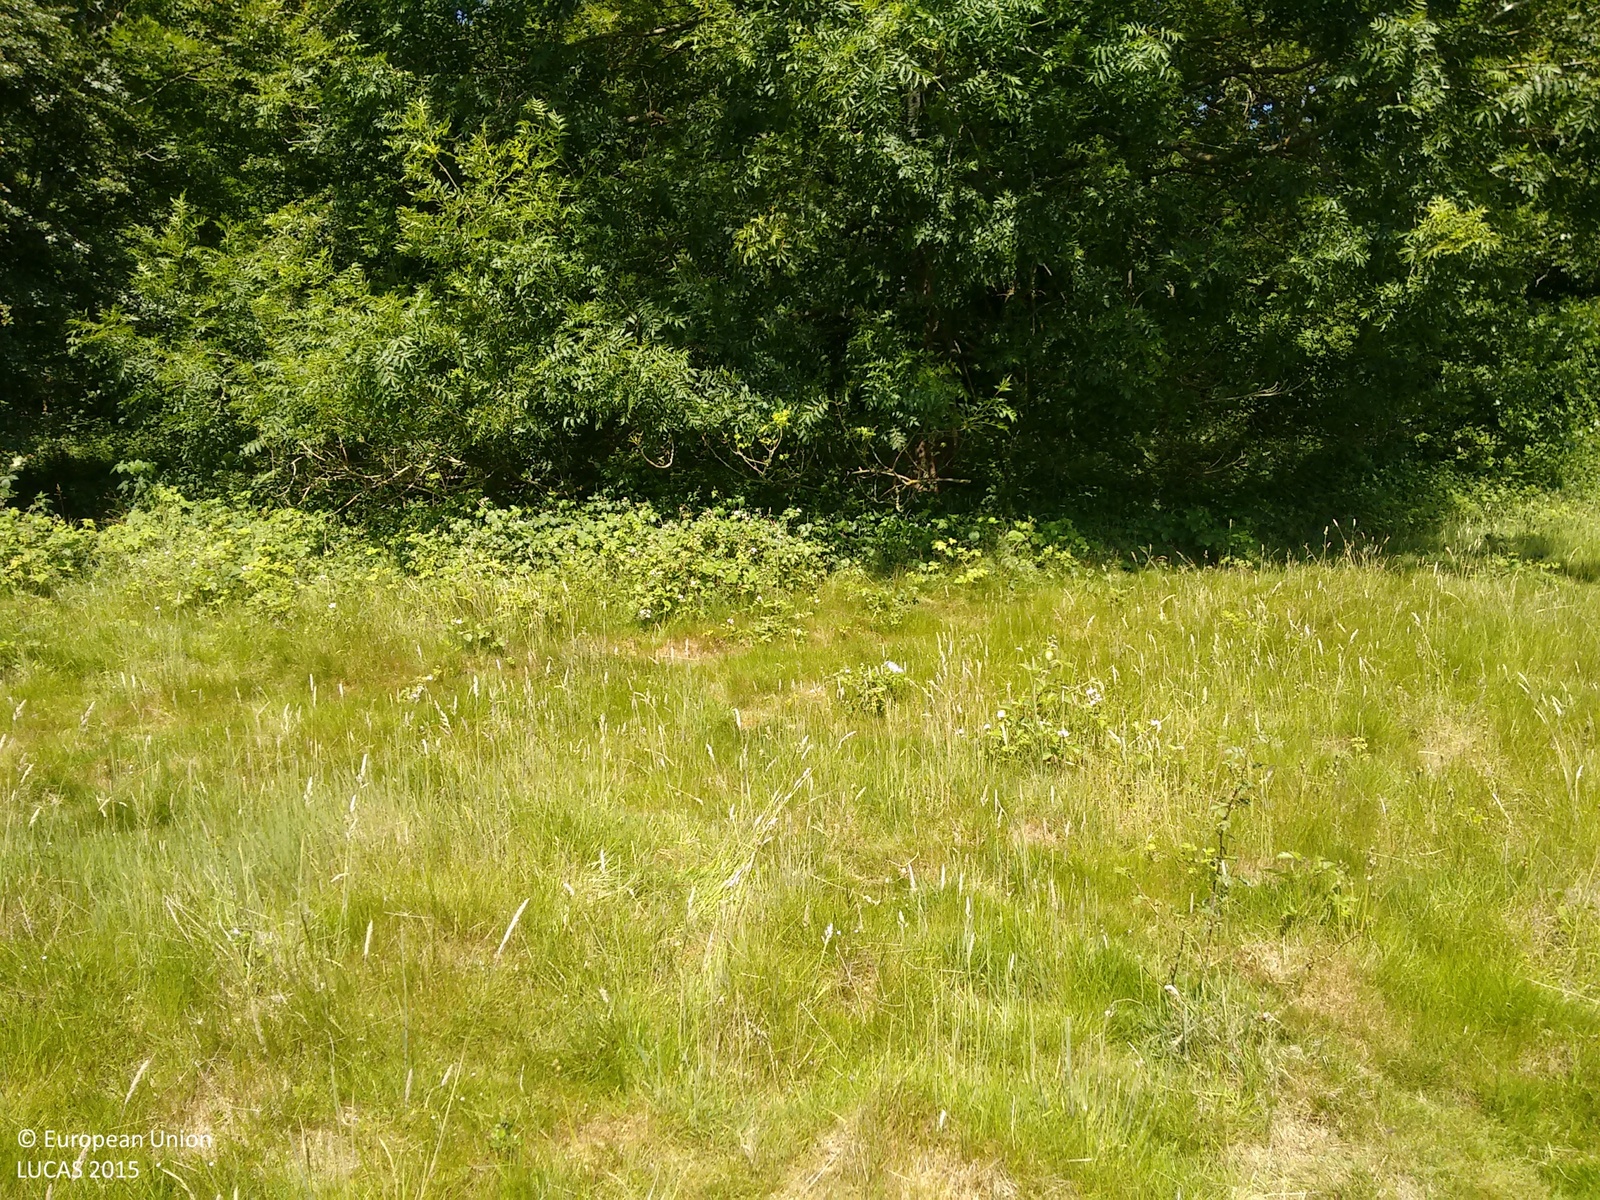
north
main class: Grassland
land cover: Grassland without tree/shrub cover
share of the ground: > 75 %
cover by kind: herbaceous plants 100 %
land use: Semi-natural and natural areas not in use
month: June
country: GB
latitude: 51.2133
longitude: -0.1846
